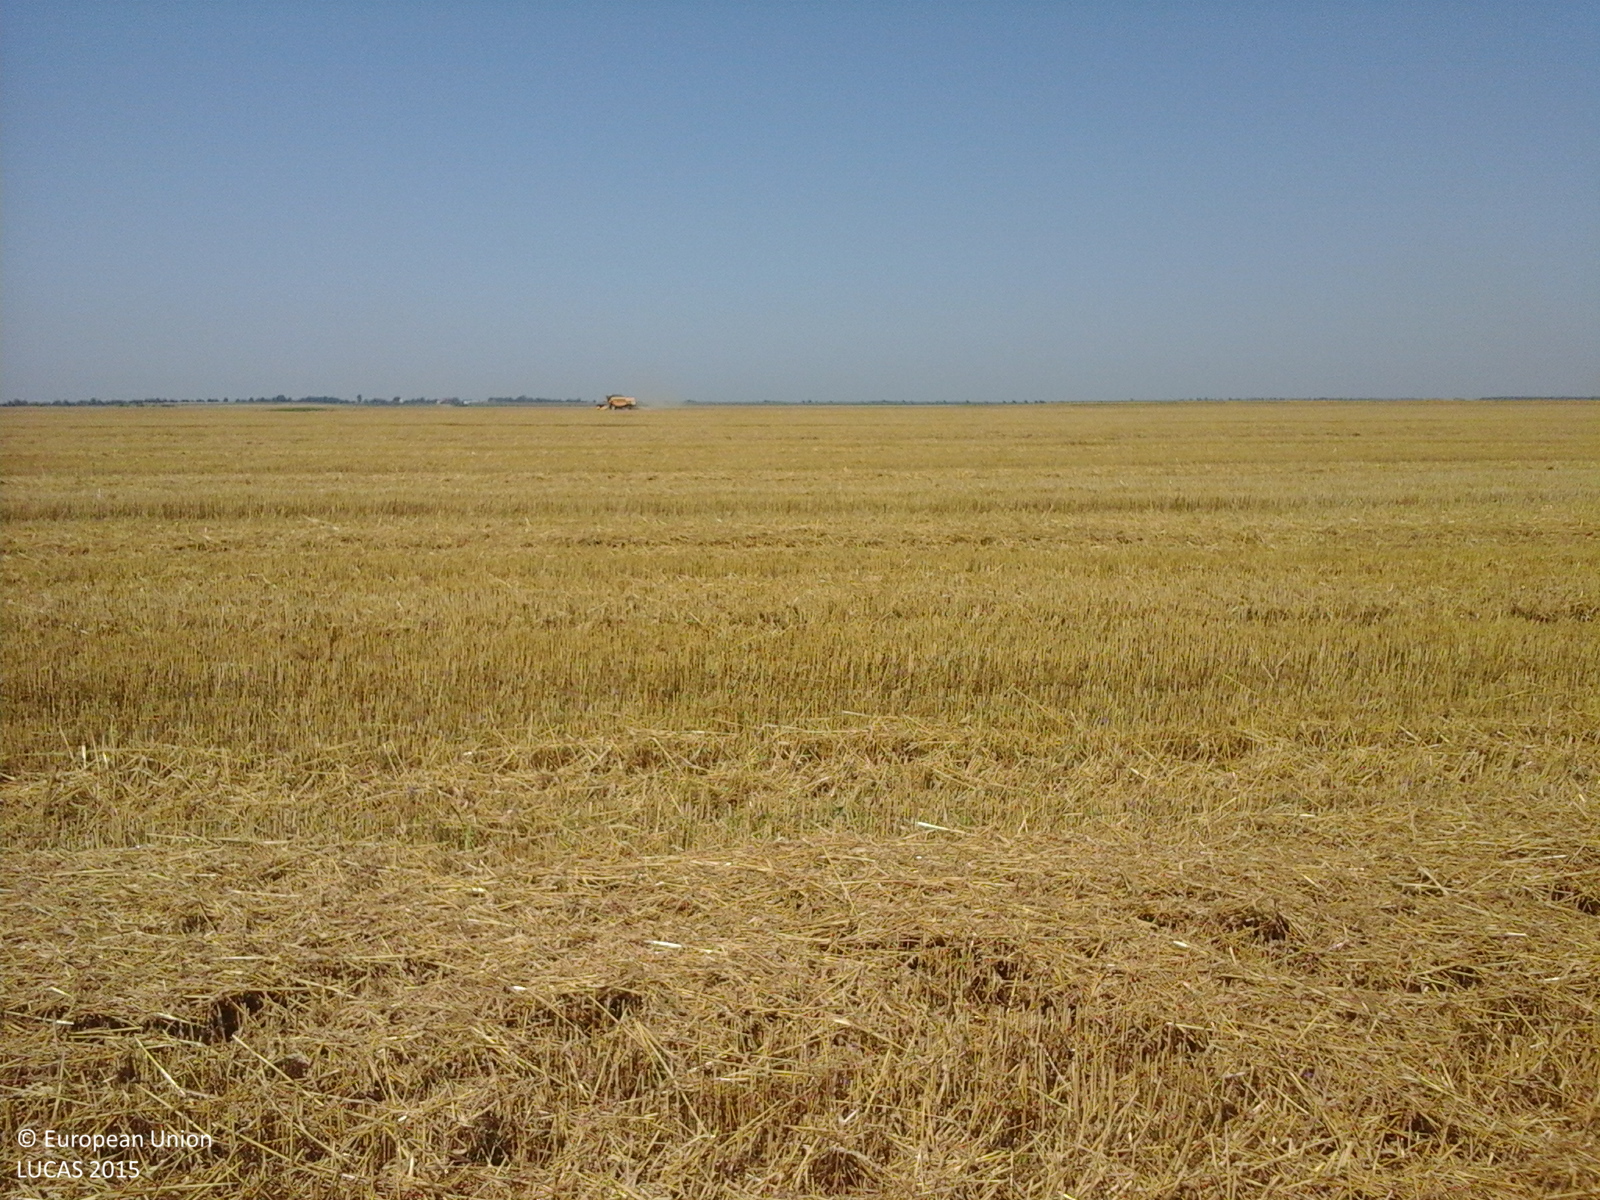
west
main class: Cropland
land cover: Common wheat
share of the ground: < 10 %
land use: Agriculture (excluding fallow land and kitchen gardens)
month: July
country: RO
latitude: 44.1307
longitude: 24.6308
